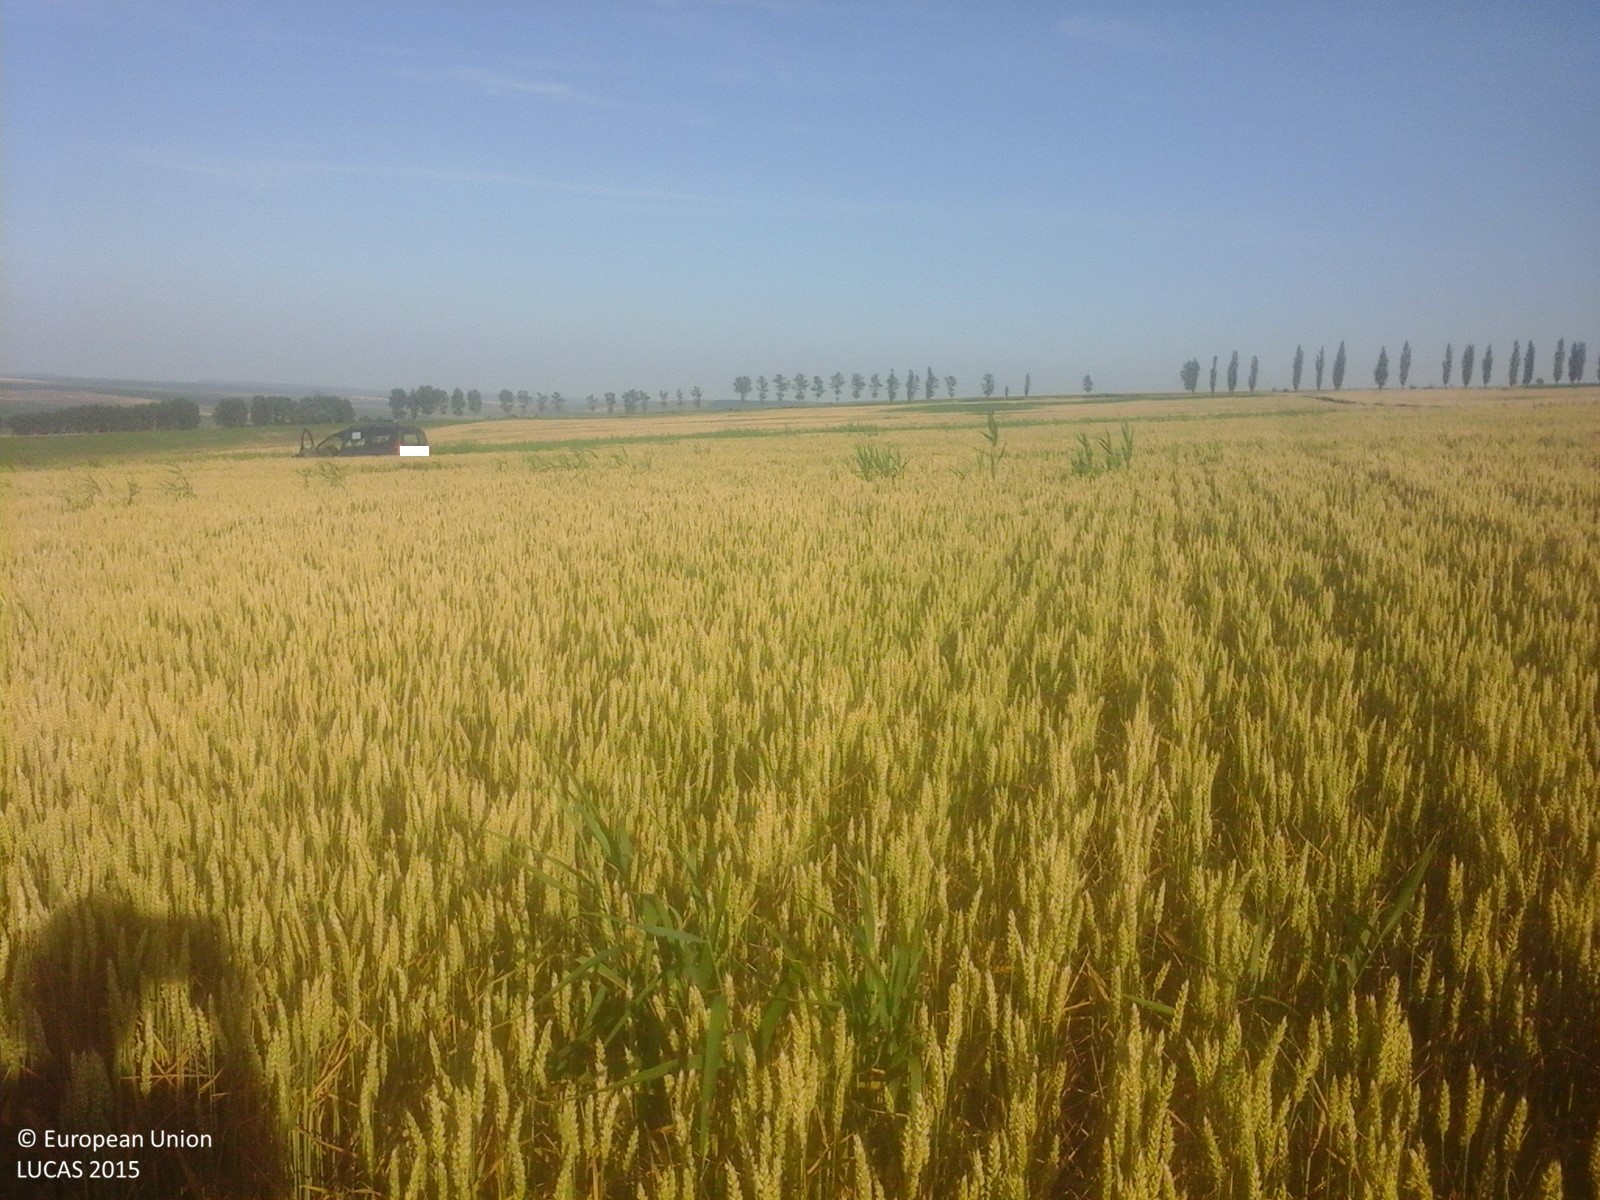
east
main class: Cropland
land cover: Common wheat
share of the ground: > 75 %
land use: Agriculture (excluding fallow land and kitchen gardens)
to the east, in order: Common wheat; Tracks; Common wheat
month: June
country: RO
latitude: 47.9094
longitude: 26.9488
